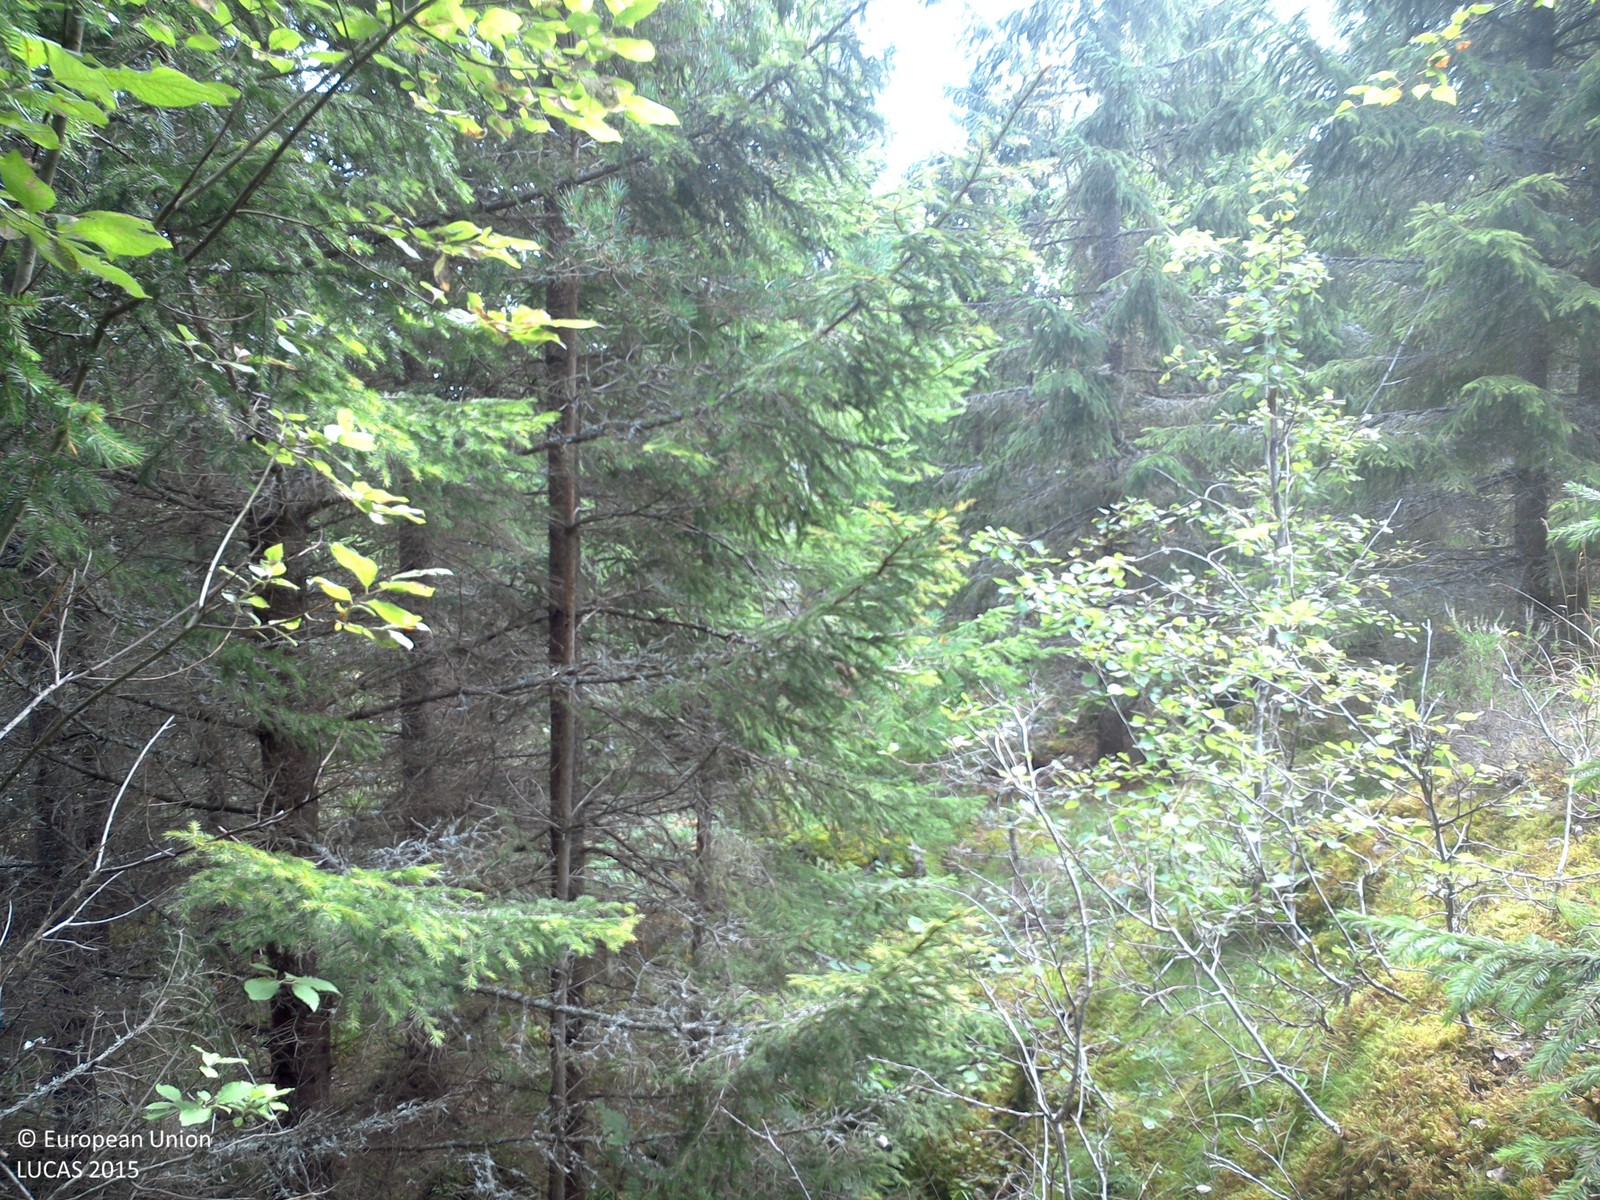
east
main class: Woodland
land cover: Spruce dominated coniferous woodland
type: boreal forest
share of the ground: 50 - 75 %
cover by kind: coniferous forest trees 55 %, lichens and mosses 30 %, herbaceous plants 15 %
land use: Forestry
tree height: > 5 m
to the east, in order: Spruce dominated coniferous woodland; Other bare soil; Spruce dominated coniferous woodland; Spruce dominated mixed woodland; Inland marshes; Spruce dominated mixed woodland
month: August
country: SE
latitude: 57.8543
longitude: 15.5061
